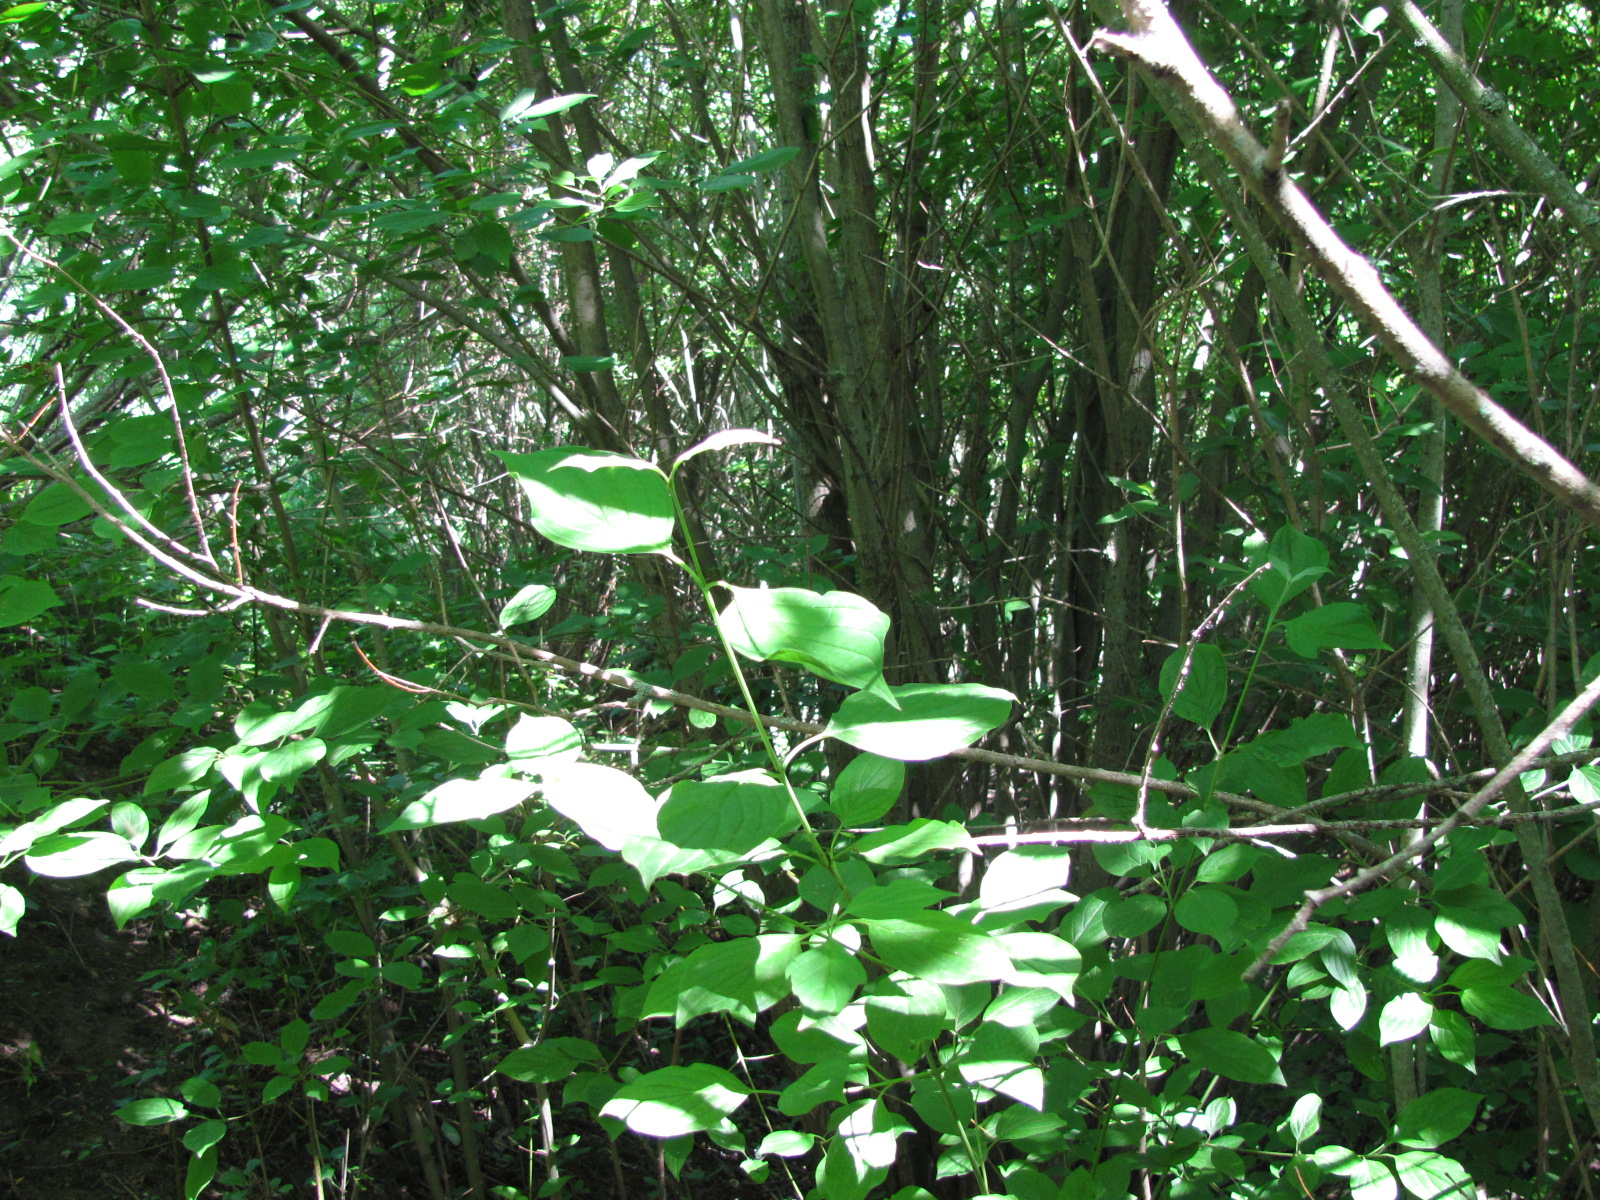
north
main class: Woodland
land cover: Broadleaved woodland
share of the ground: > 75 %
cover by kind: broadleaved forest trees 100 %
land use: Semi-natural and natural areas not in use
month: July
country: LV
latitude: 56.5067
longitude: 23.7114
